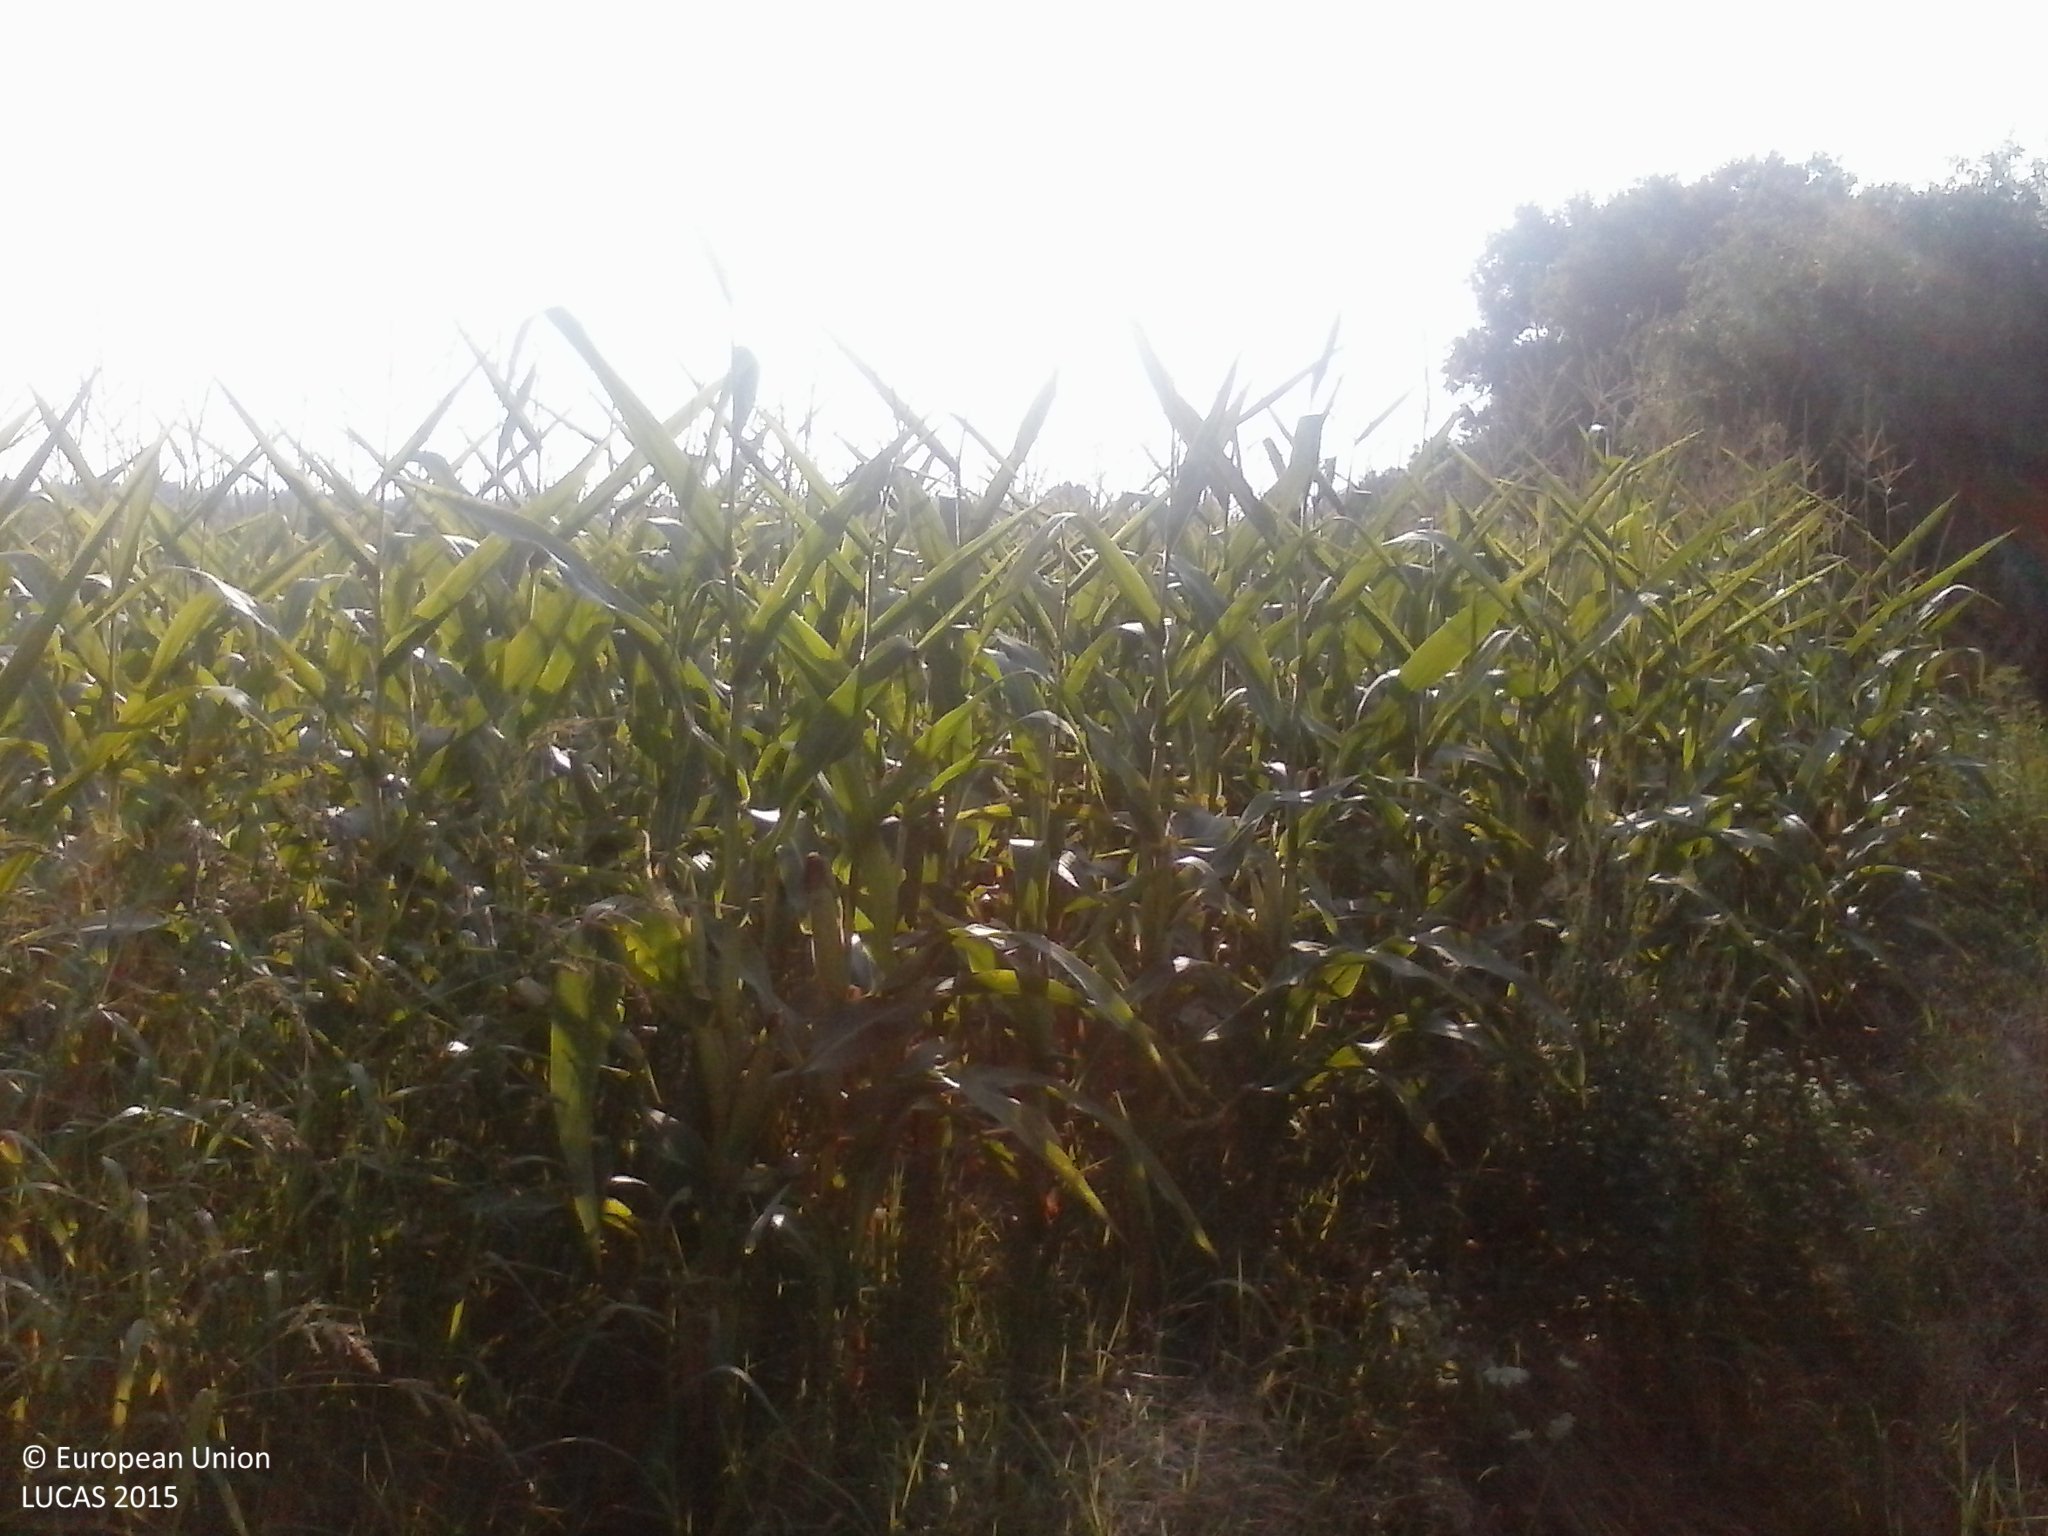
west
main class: Cropland
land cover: Maize
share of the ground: > 75 %
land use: Agriculture (excluding fallow land and kitchen gardens)
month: August
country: HU
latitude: 45.9037
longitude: 18.0360
